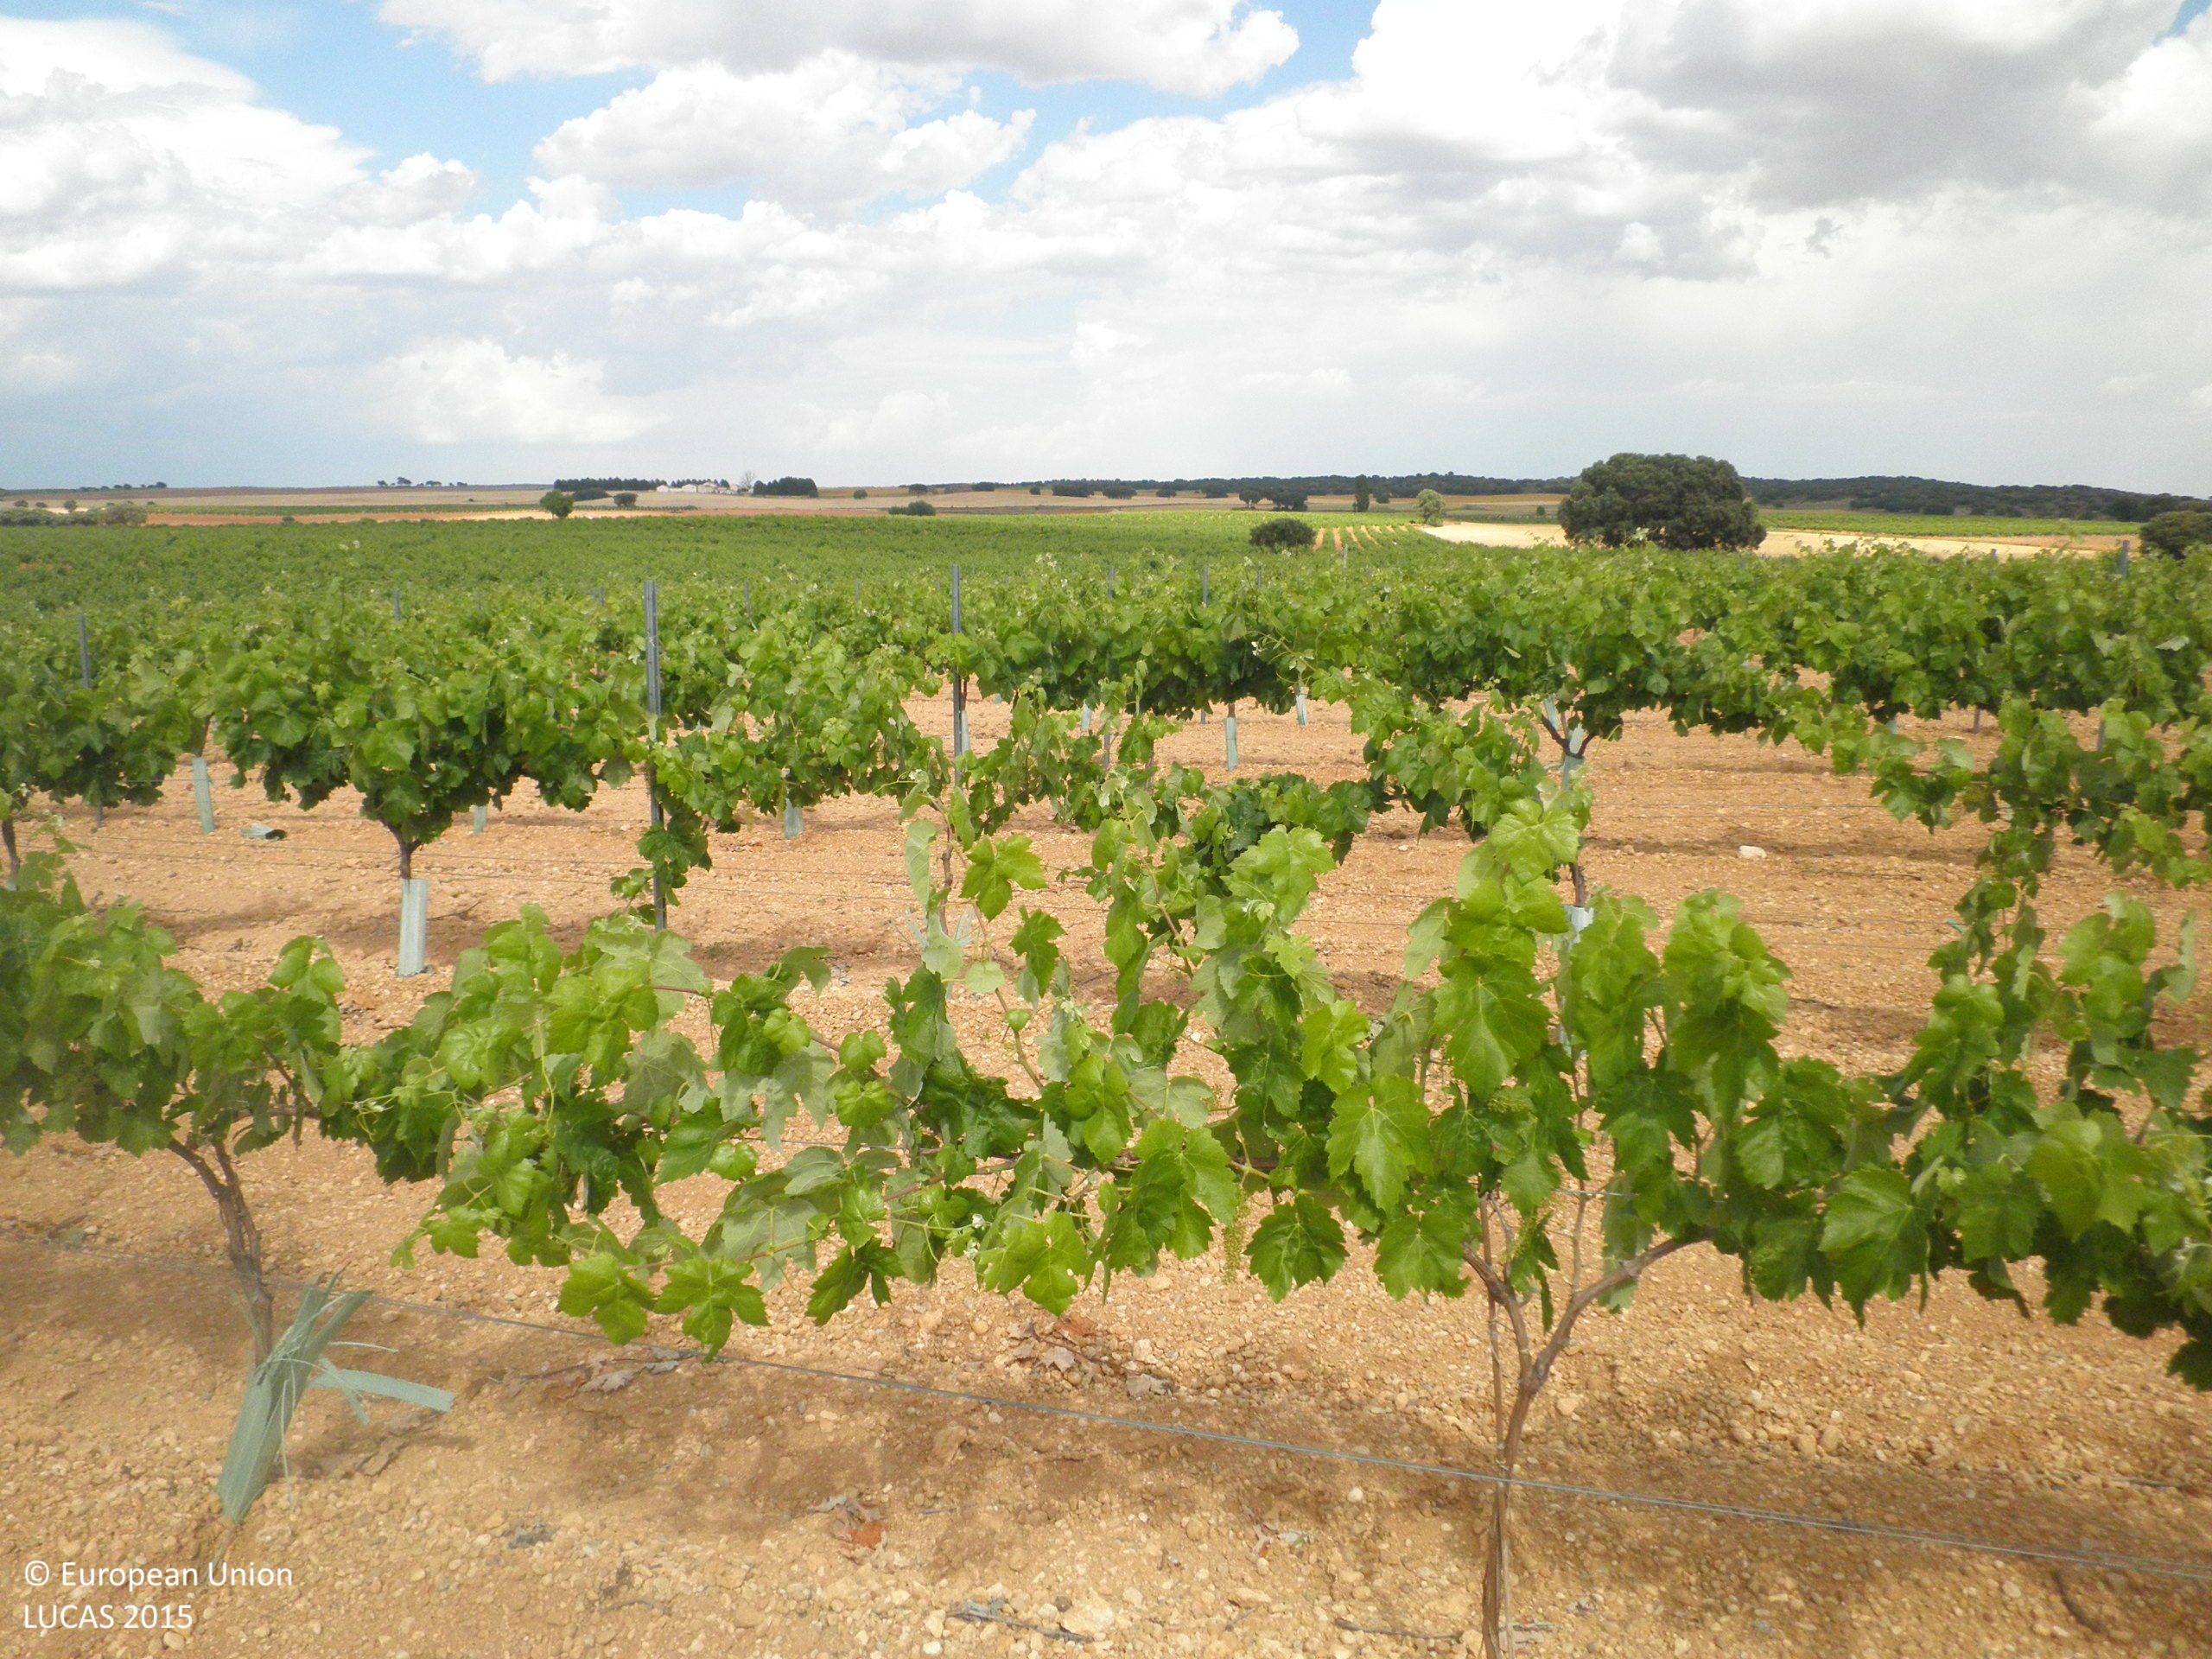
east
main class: Cropland
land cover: Vineyards
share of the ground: < 10 %
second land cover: Other bare soil
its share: > 75 %
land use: Agriculture (excluding fallow land and kitchen gardens)
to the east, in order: Vineyards; Other bare soil; Tracks; Grass margins; Vineyards
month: June
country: ES
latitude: 39.4760
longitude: -1.8287
